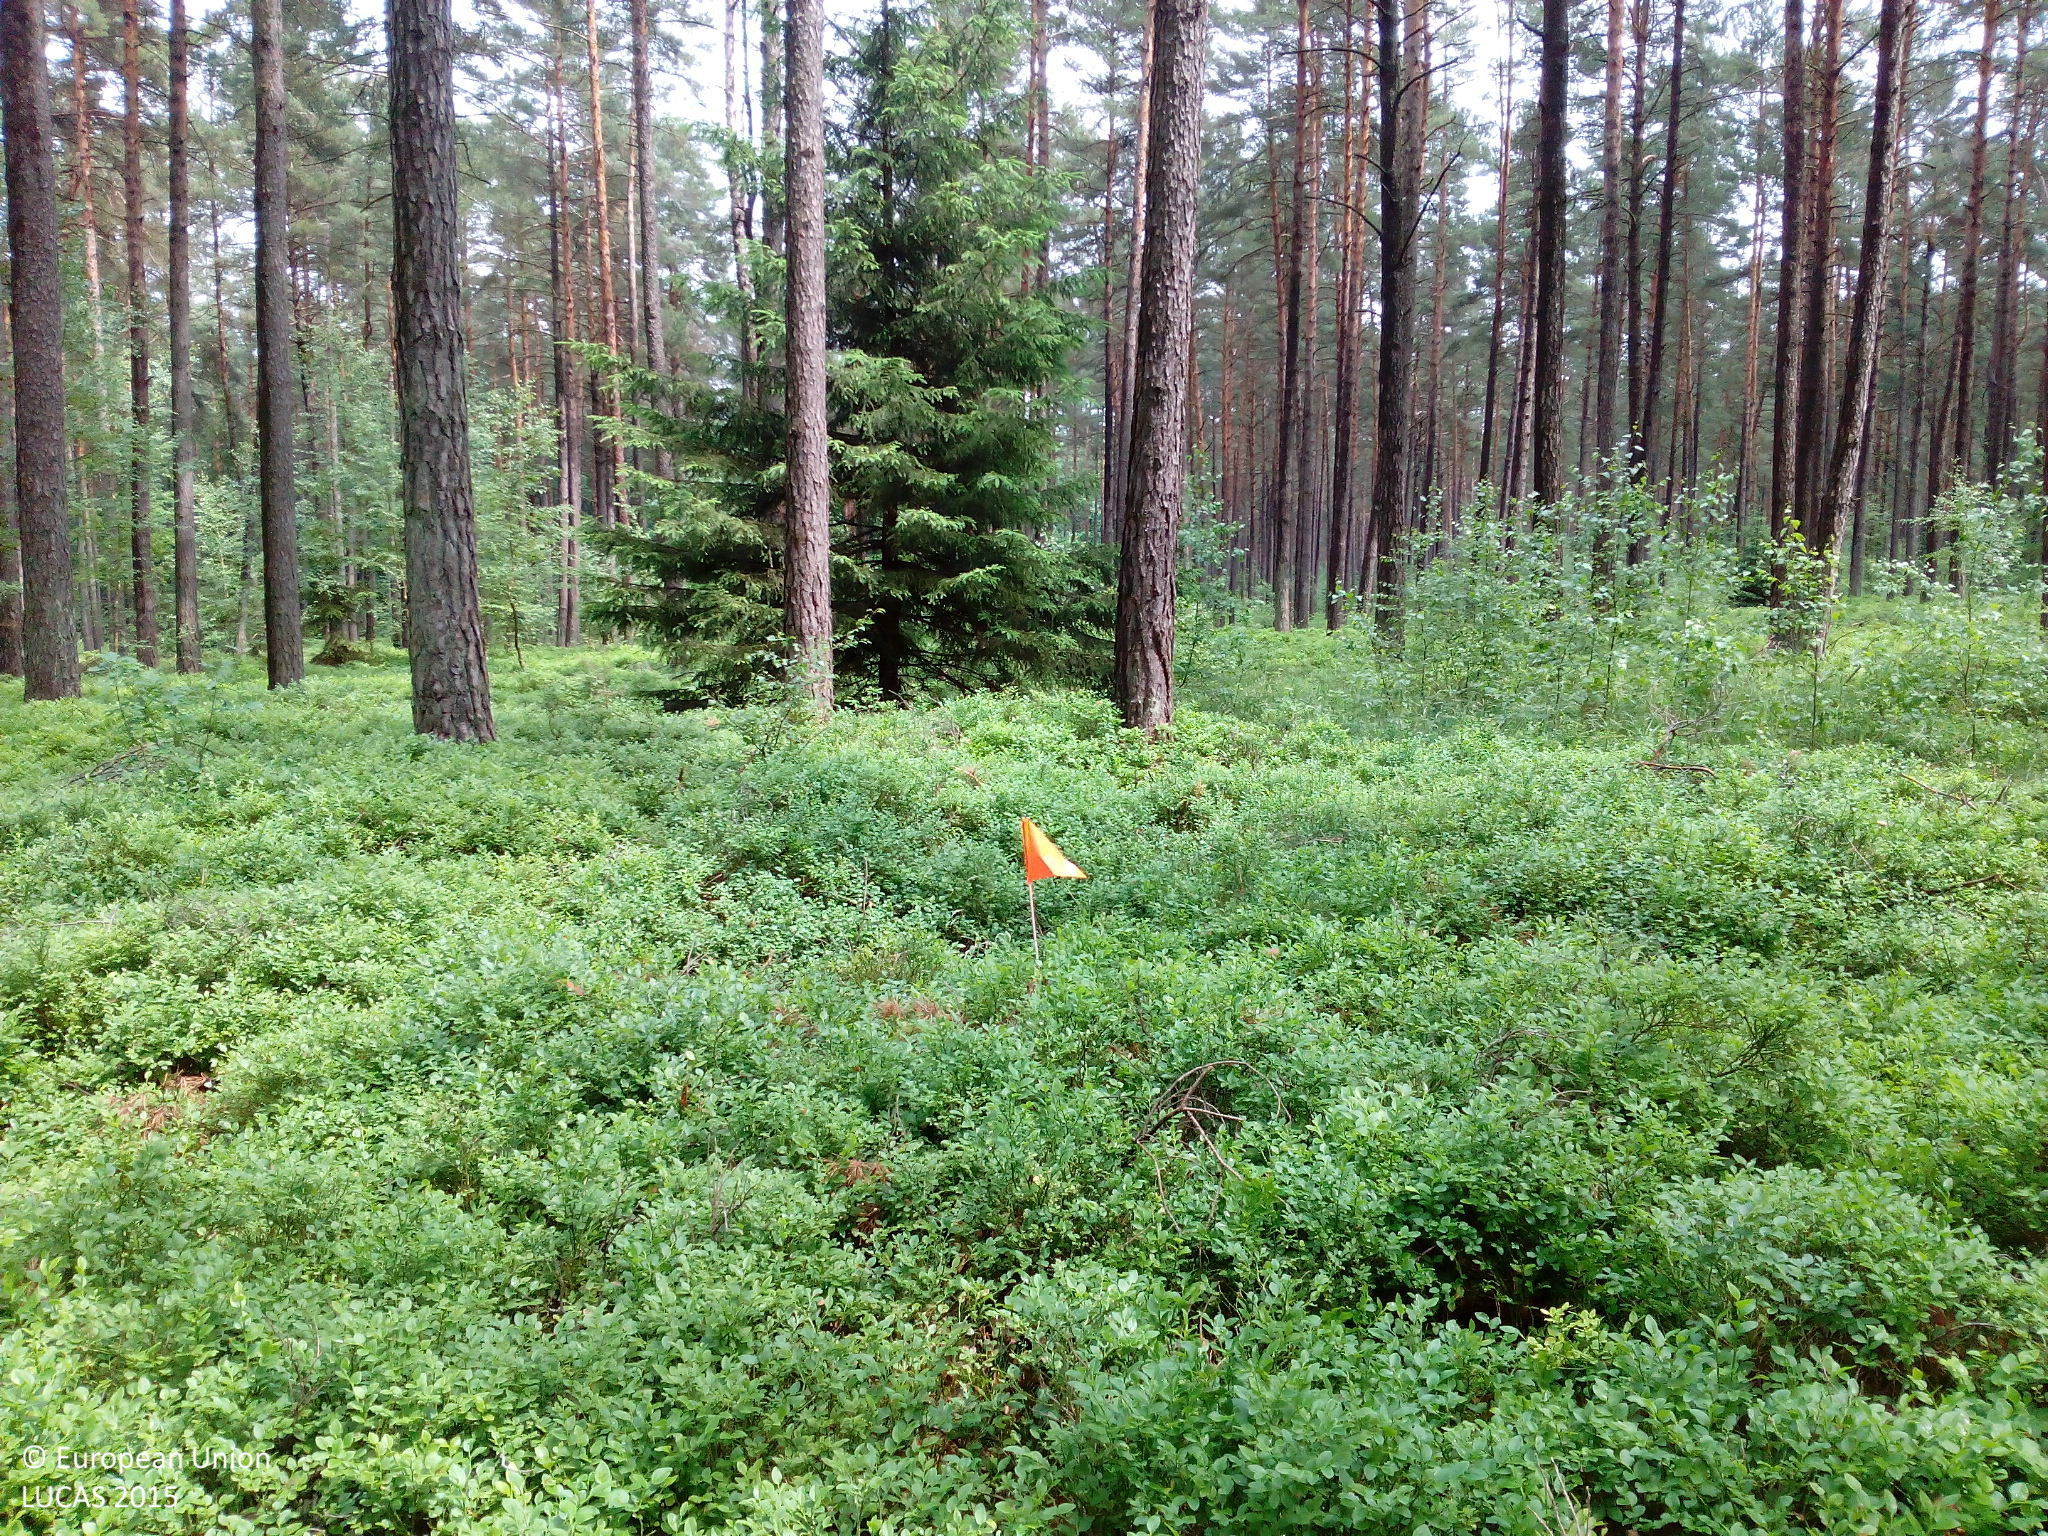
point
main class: Woodland
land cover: Pine dominated coniferous woodland
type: hemiboreal forest and nemoral coniferous forest and mixed broadleaved-coniferous forest
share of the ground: 25 - 50 %
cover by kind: coniferous forest trees 45 %, shrubs 35 %, broadleaved forest trees 10 %, herbaceous plants 10 %
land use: Forestry
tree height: > 5 m
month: June
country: DE
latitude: 49.2992
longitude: 12.2135
